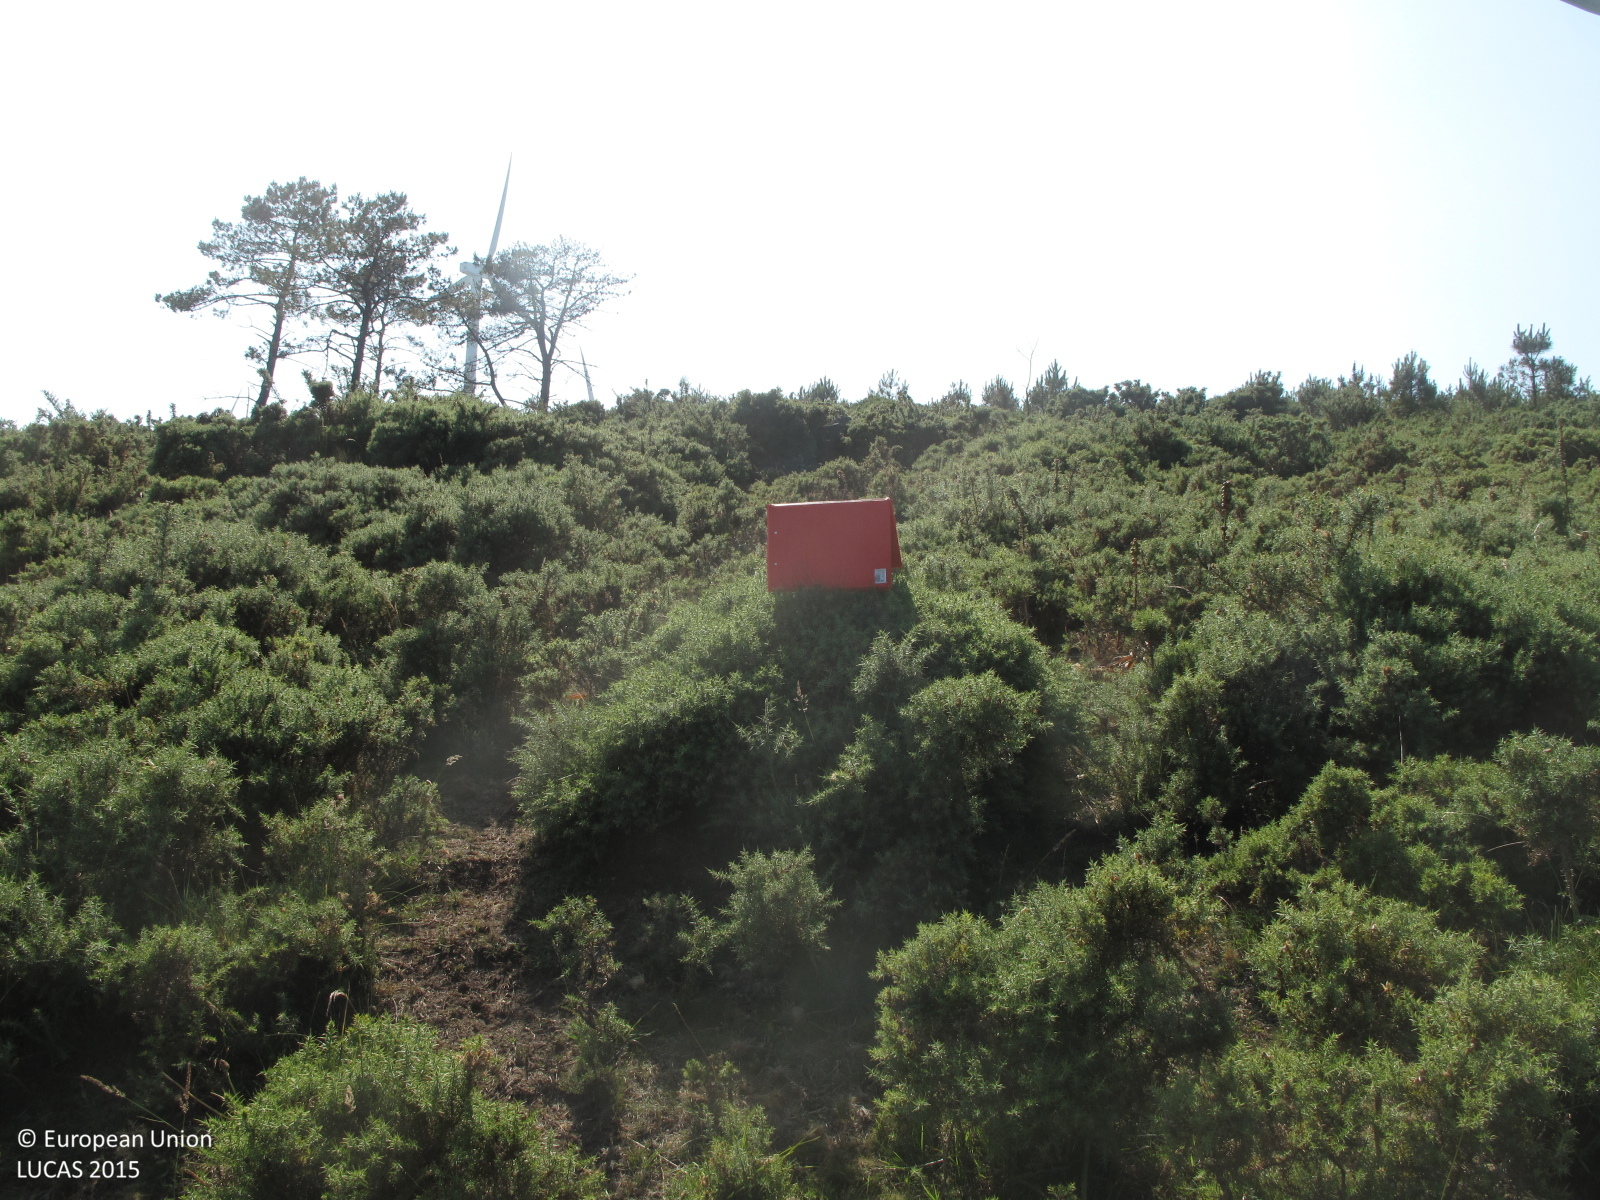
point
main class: Shrubland
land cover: Shrubland without tree cover
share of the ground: > 75 %
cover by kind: shrubs 80 %, herbaceous plants 10 %, unconsolidated bare surface 10 %
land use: Abandoned areas
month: June
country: ES
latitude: 43.2600
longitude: -7.9921
